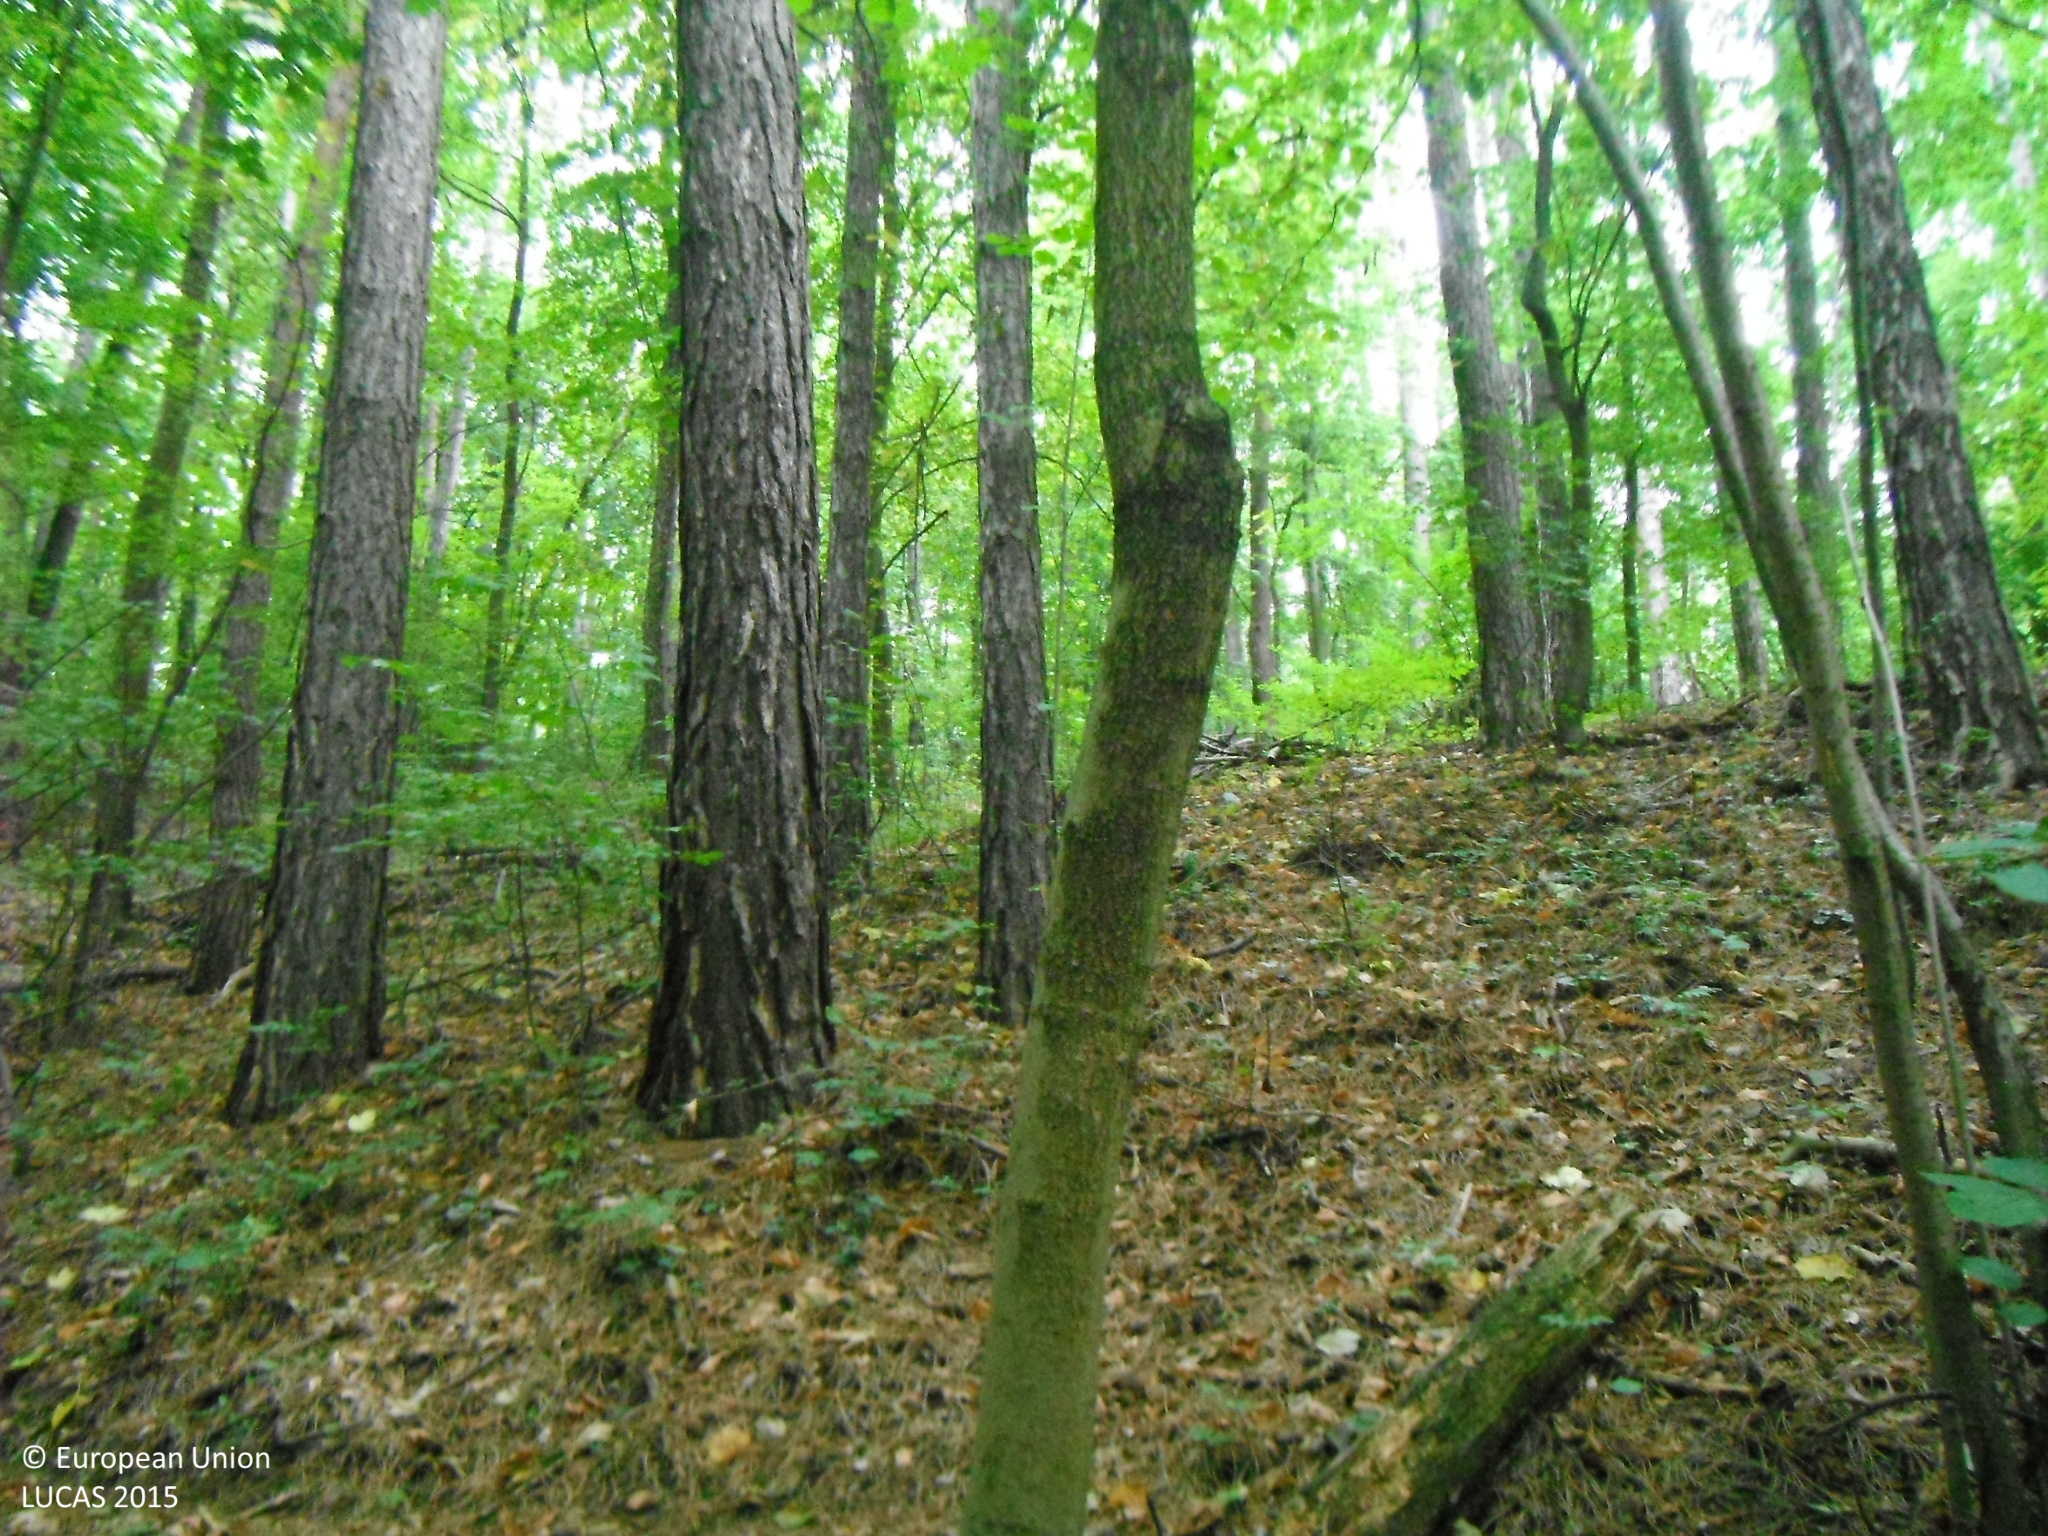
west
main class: Woodland
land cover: Pine dominated mixed woodland
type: hemiboreal forest and nemoral coniferous forest and mixed broadleaved-coniferous forest
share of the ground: > 75 %
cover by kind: coniferous forest trees 45 %, broadleaved forest trees 45 %, shrubs 5 %, unconsolidated bare surface 5 %
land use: Forestry
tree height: > 5 m
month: September
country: SK
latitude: 48.8873
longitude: 18.0473
